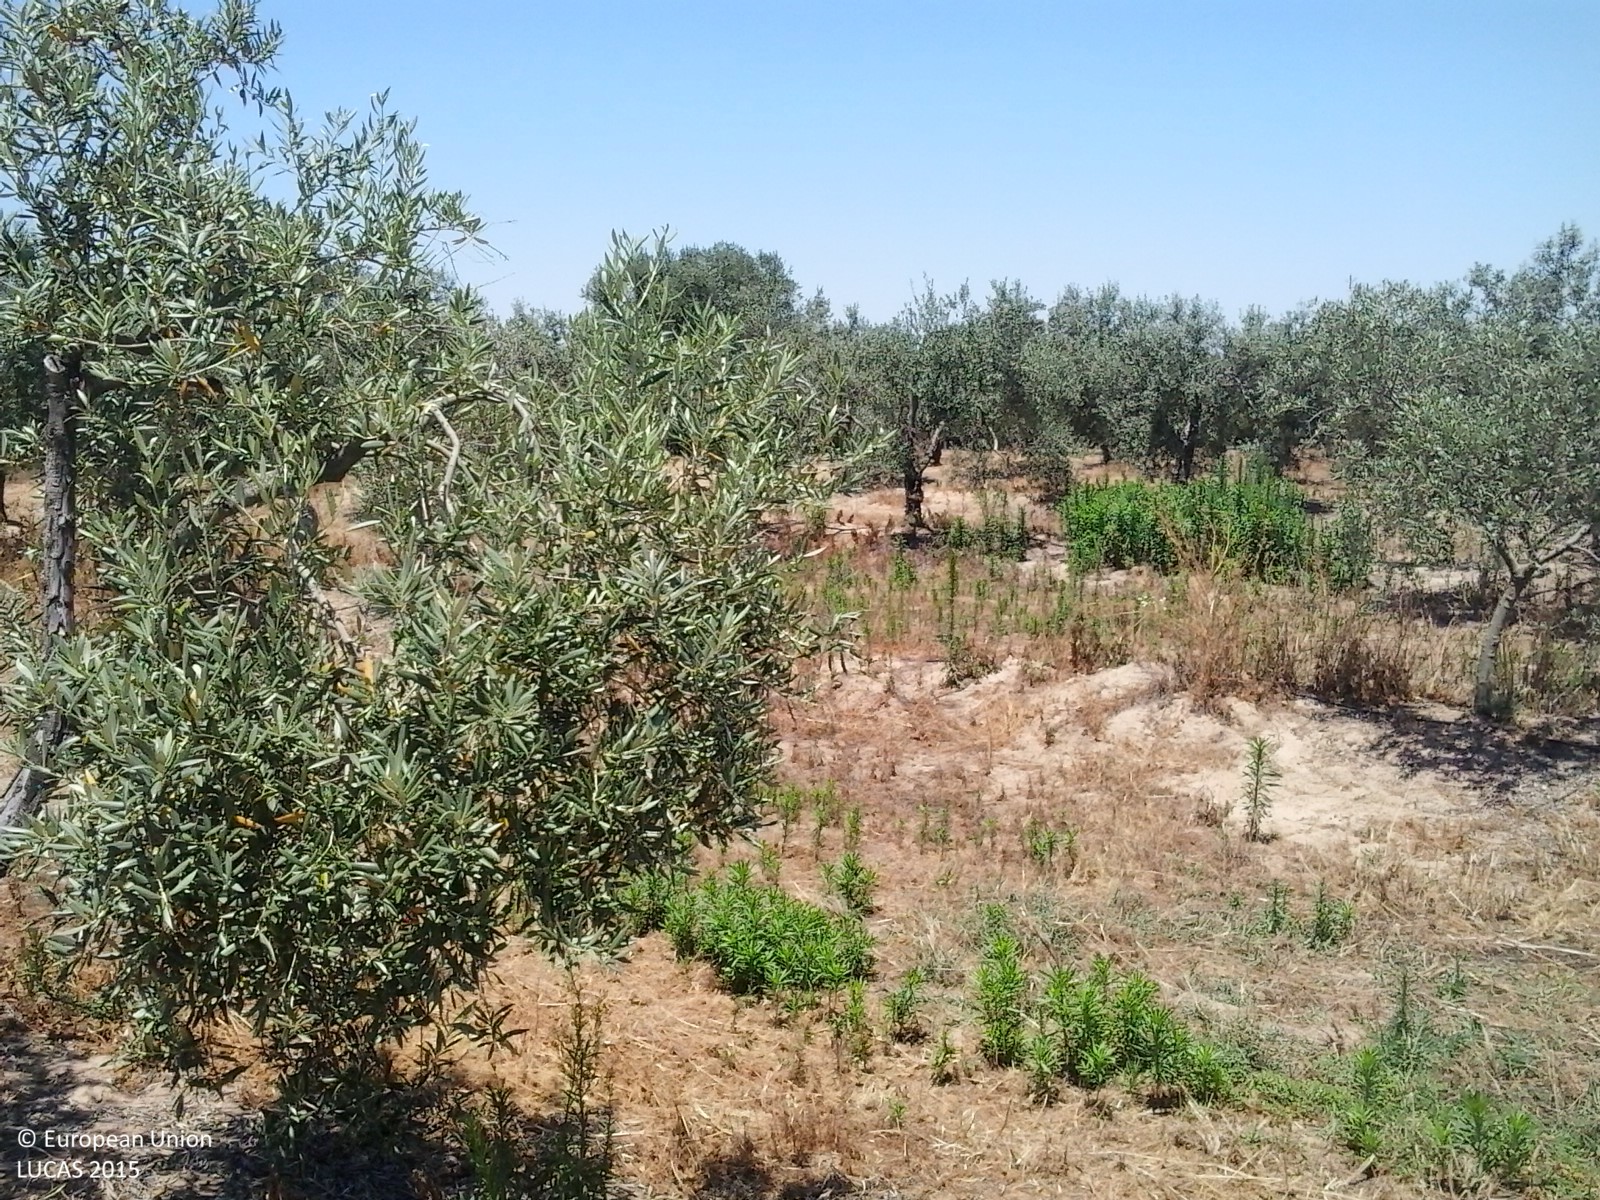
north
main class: Cropland
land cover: Olive groves
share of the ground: 10 - 25 %
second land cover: Spontaneously vegetated surfaces
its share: 50 - 75 %
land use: Agriculture (excluding fallow land and kitchen gardens)
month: June
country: ES
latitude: 37.3527
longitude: -6.3651
